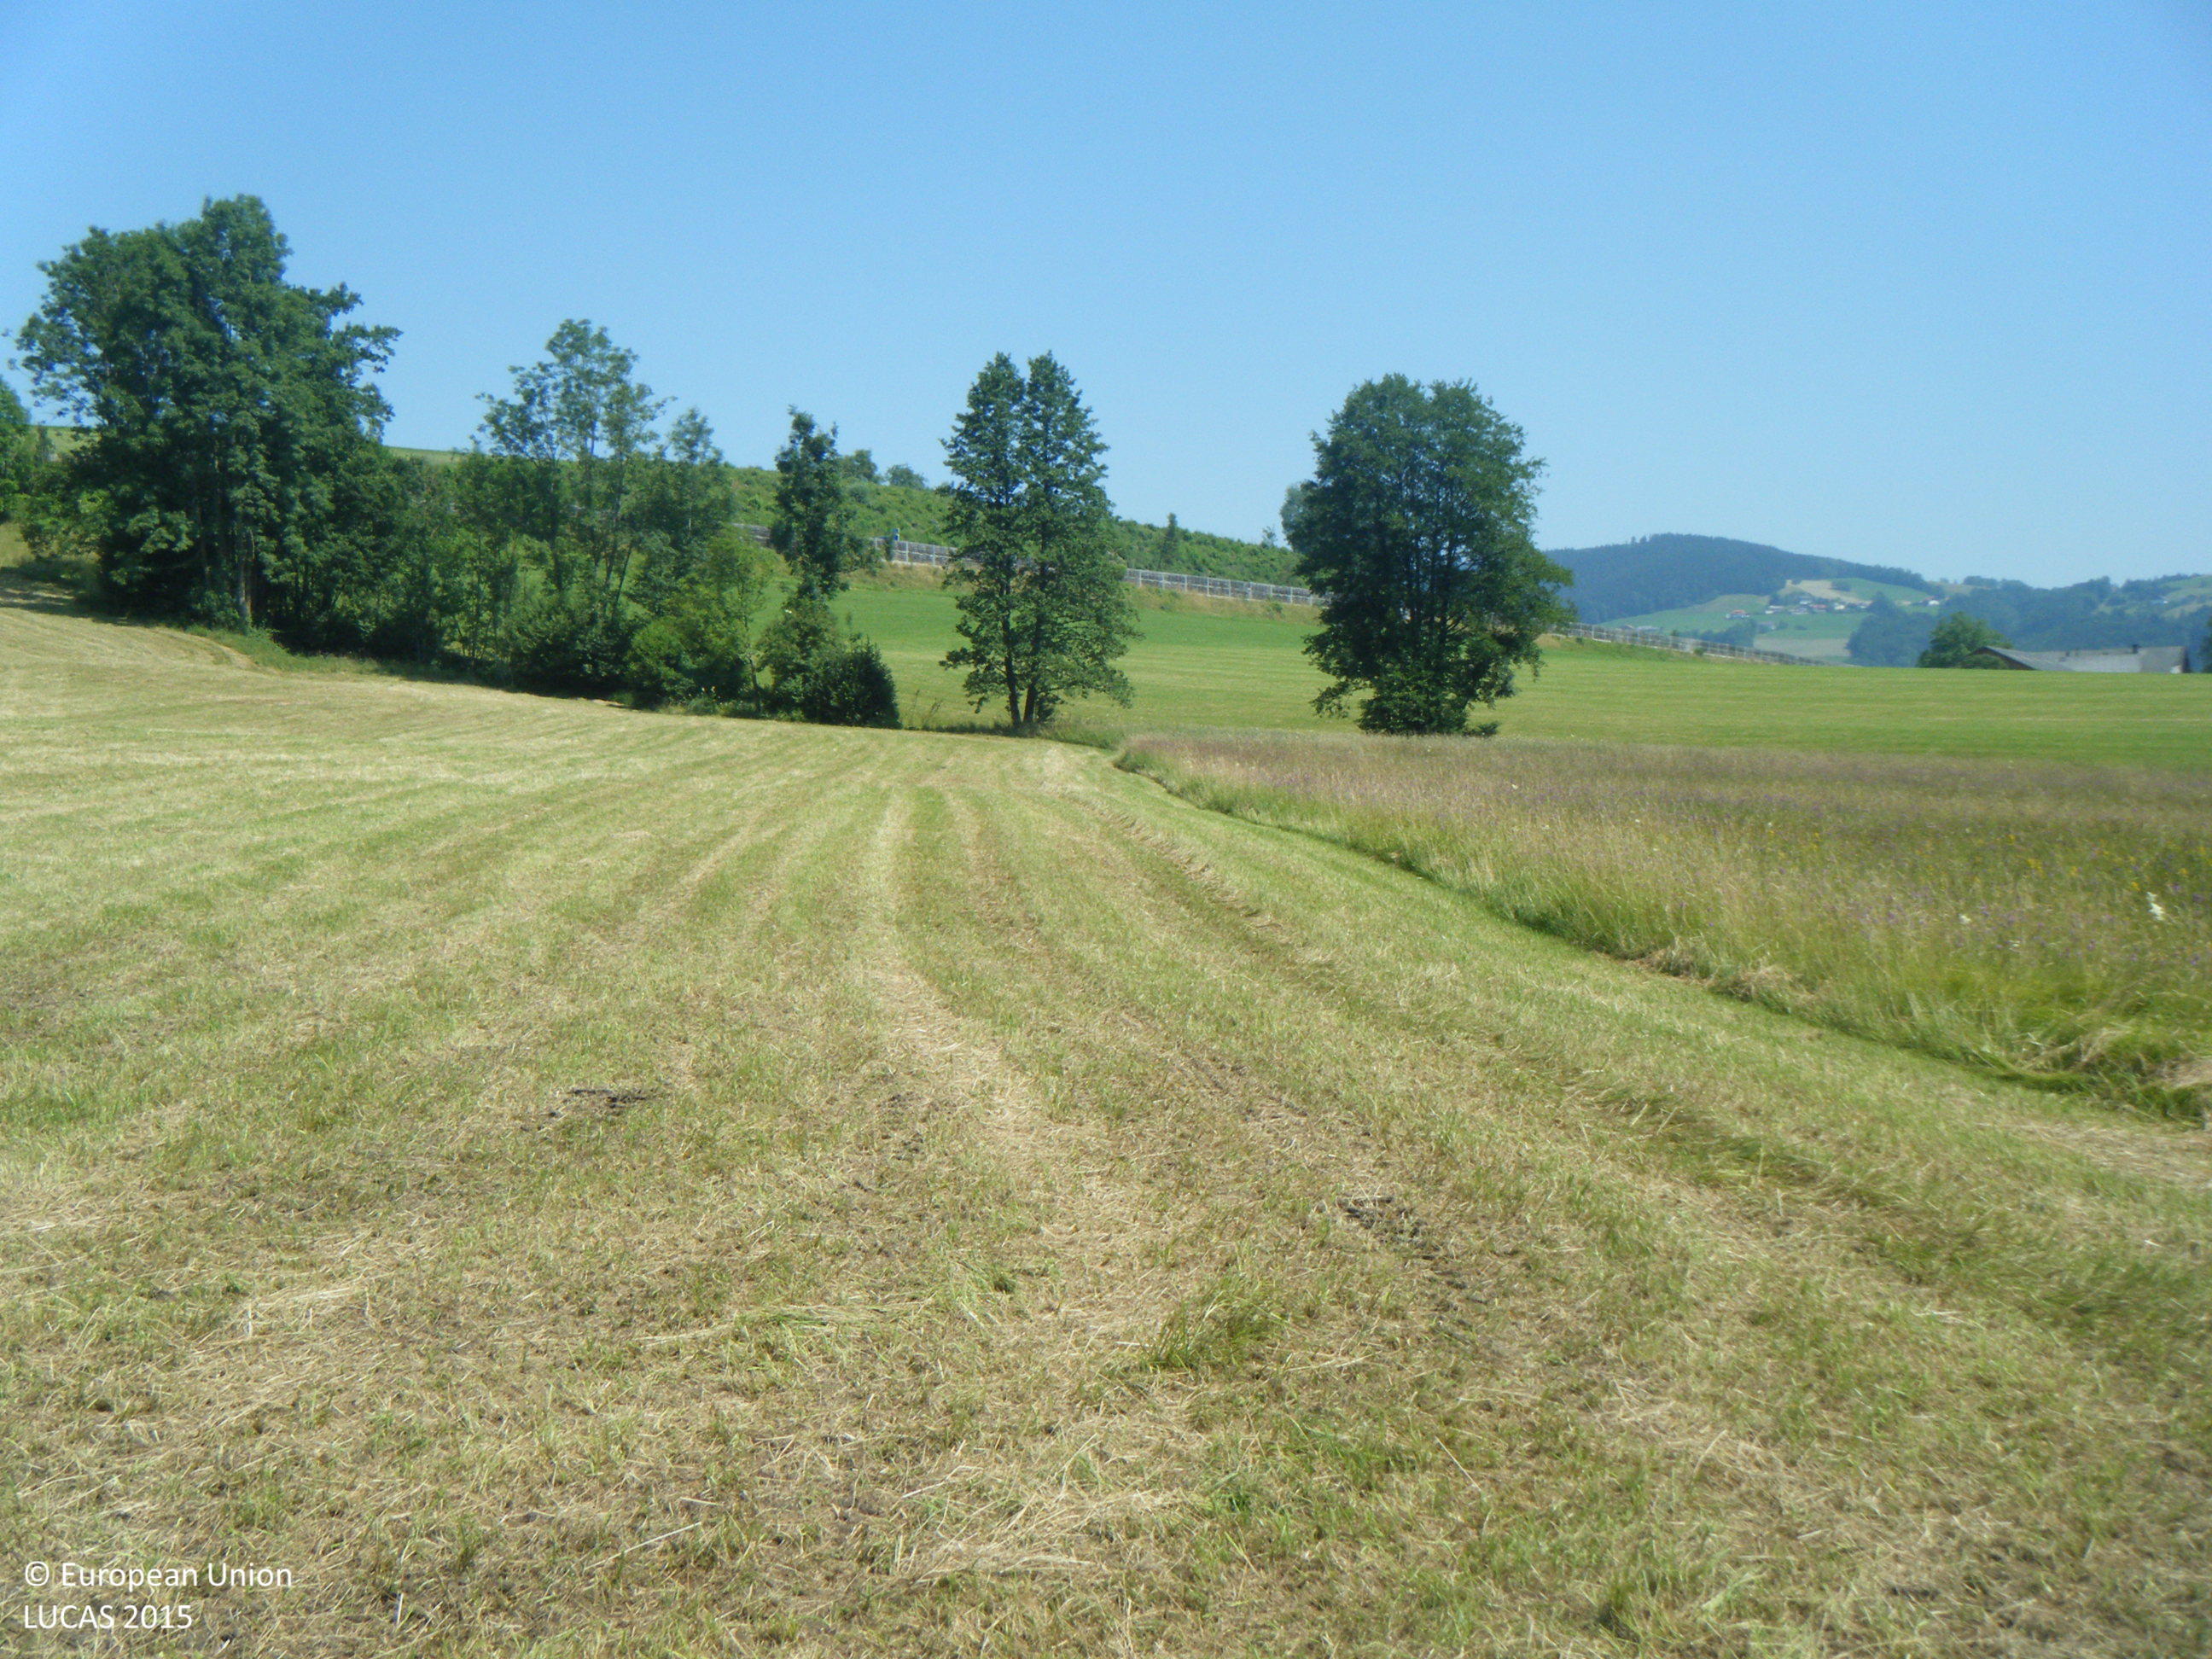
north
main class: Grassland
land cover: Grassland without tree/shrub cover
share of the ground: > 75 %
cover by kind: herbaceous plants 100 %
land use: Agriculture (excluding fallow land and kitchen gardens)
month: July
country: AT
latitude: 47.8492
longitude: 13.3263
